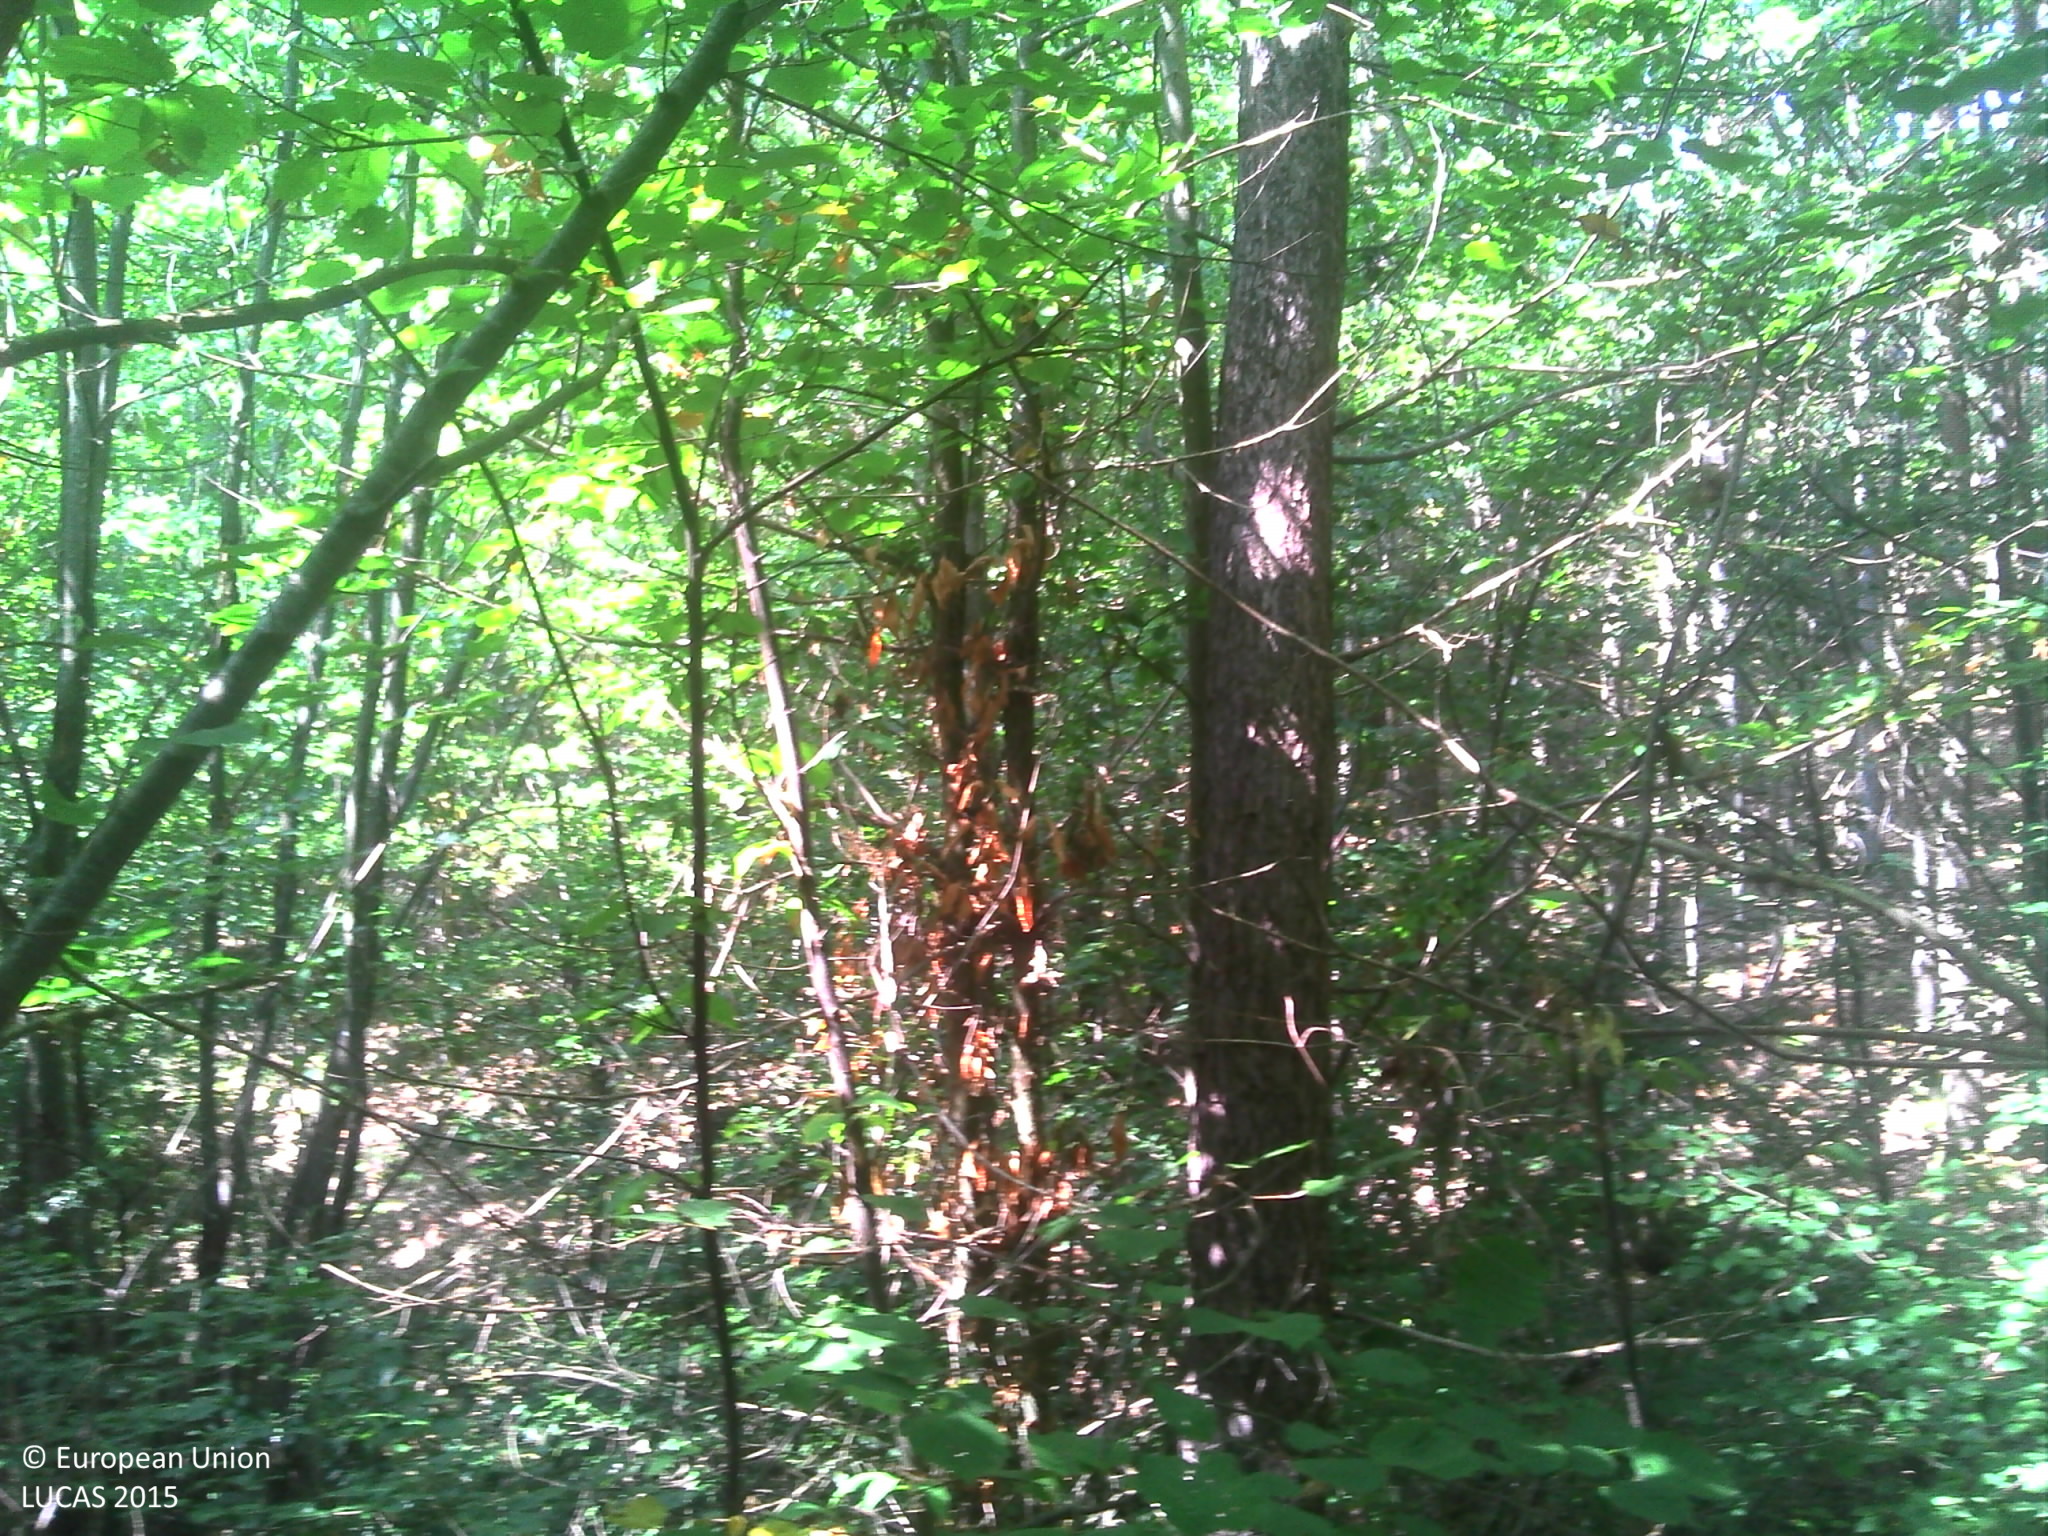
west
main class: Woodland
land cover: Broadleaved woodland
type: floodplain forest
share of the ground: > 75 %
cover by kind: broadleaved forest trees 95 %, coniferous forest trees 5 %
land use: Forestry
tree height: > 5 m
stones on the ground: 10 - 25 %
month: September
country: FR
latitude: 45.2318
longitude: 5.1777
